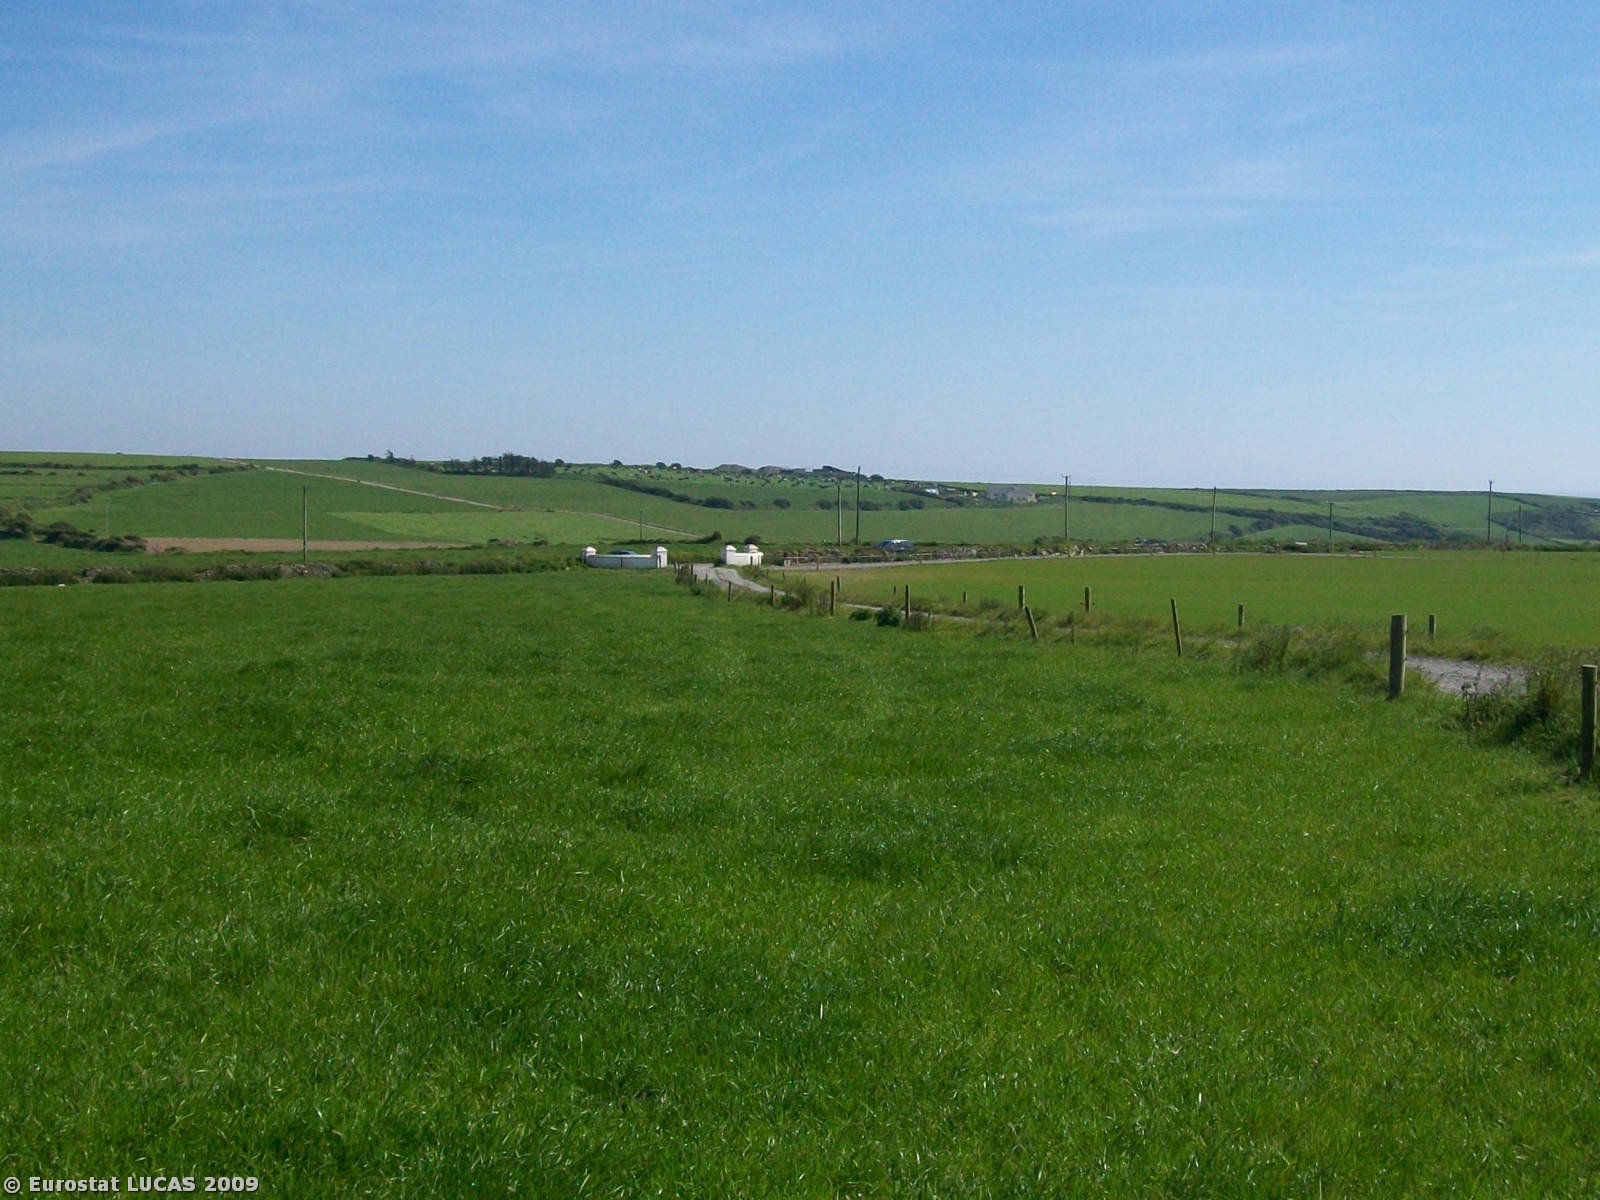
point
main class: Grassland
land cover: Grassland without tree/shrub cover
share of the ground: > 75 %
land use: Agriculture (excluding fallow land and kitchen gardens)
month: July
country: IE
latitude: 52.5262
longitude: -7.6907
